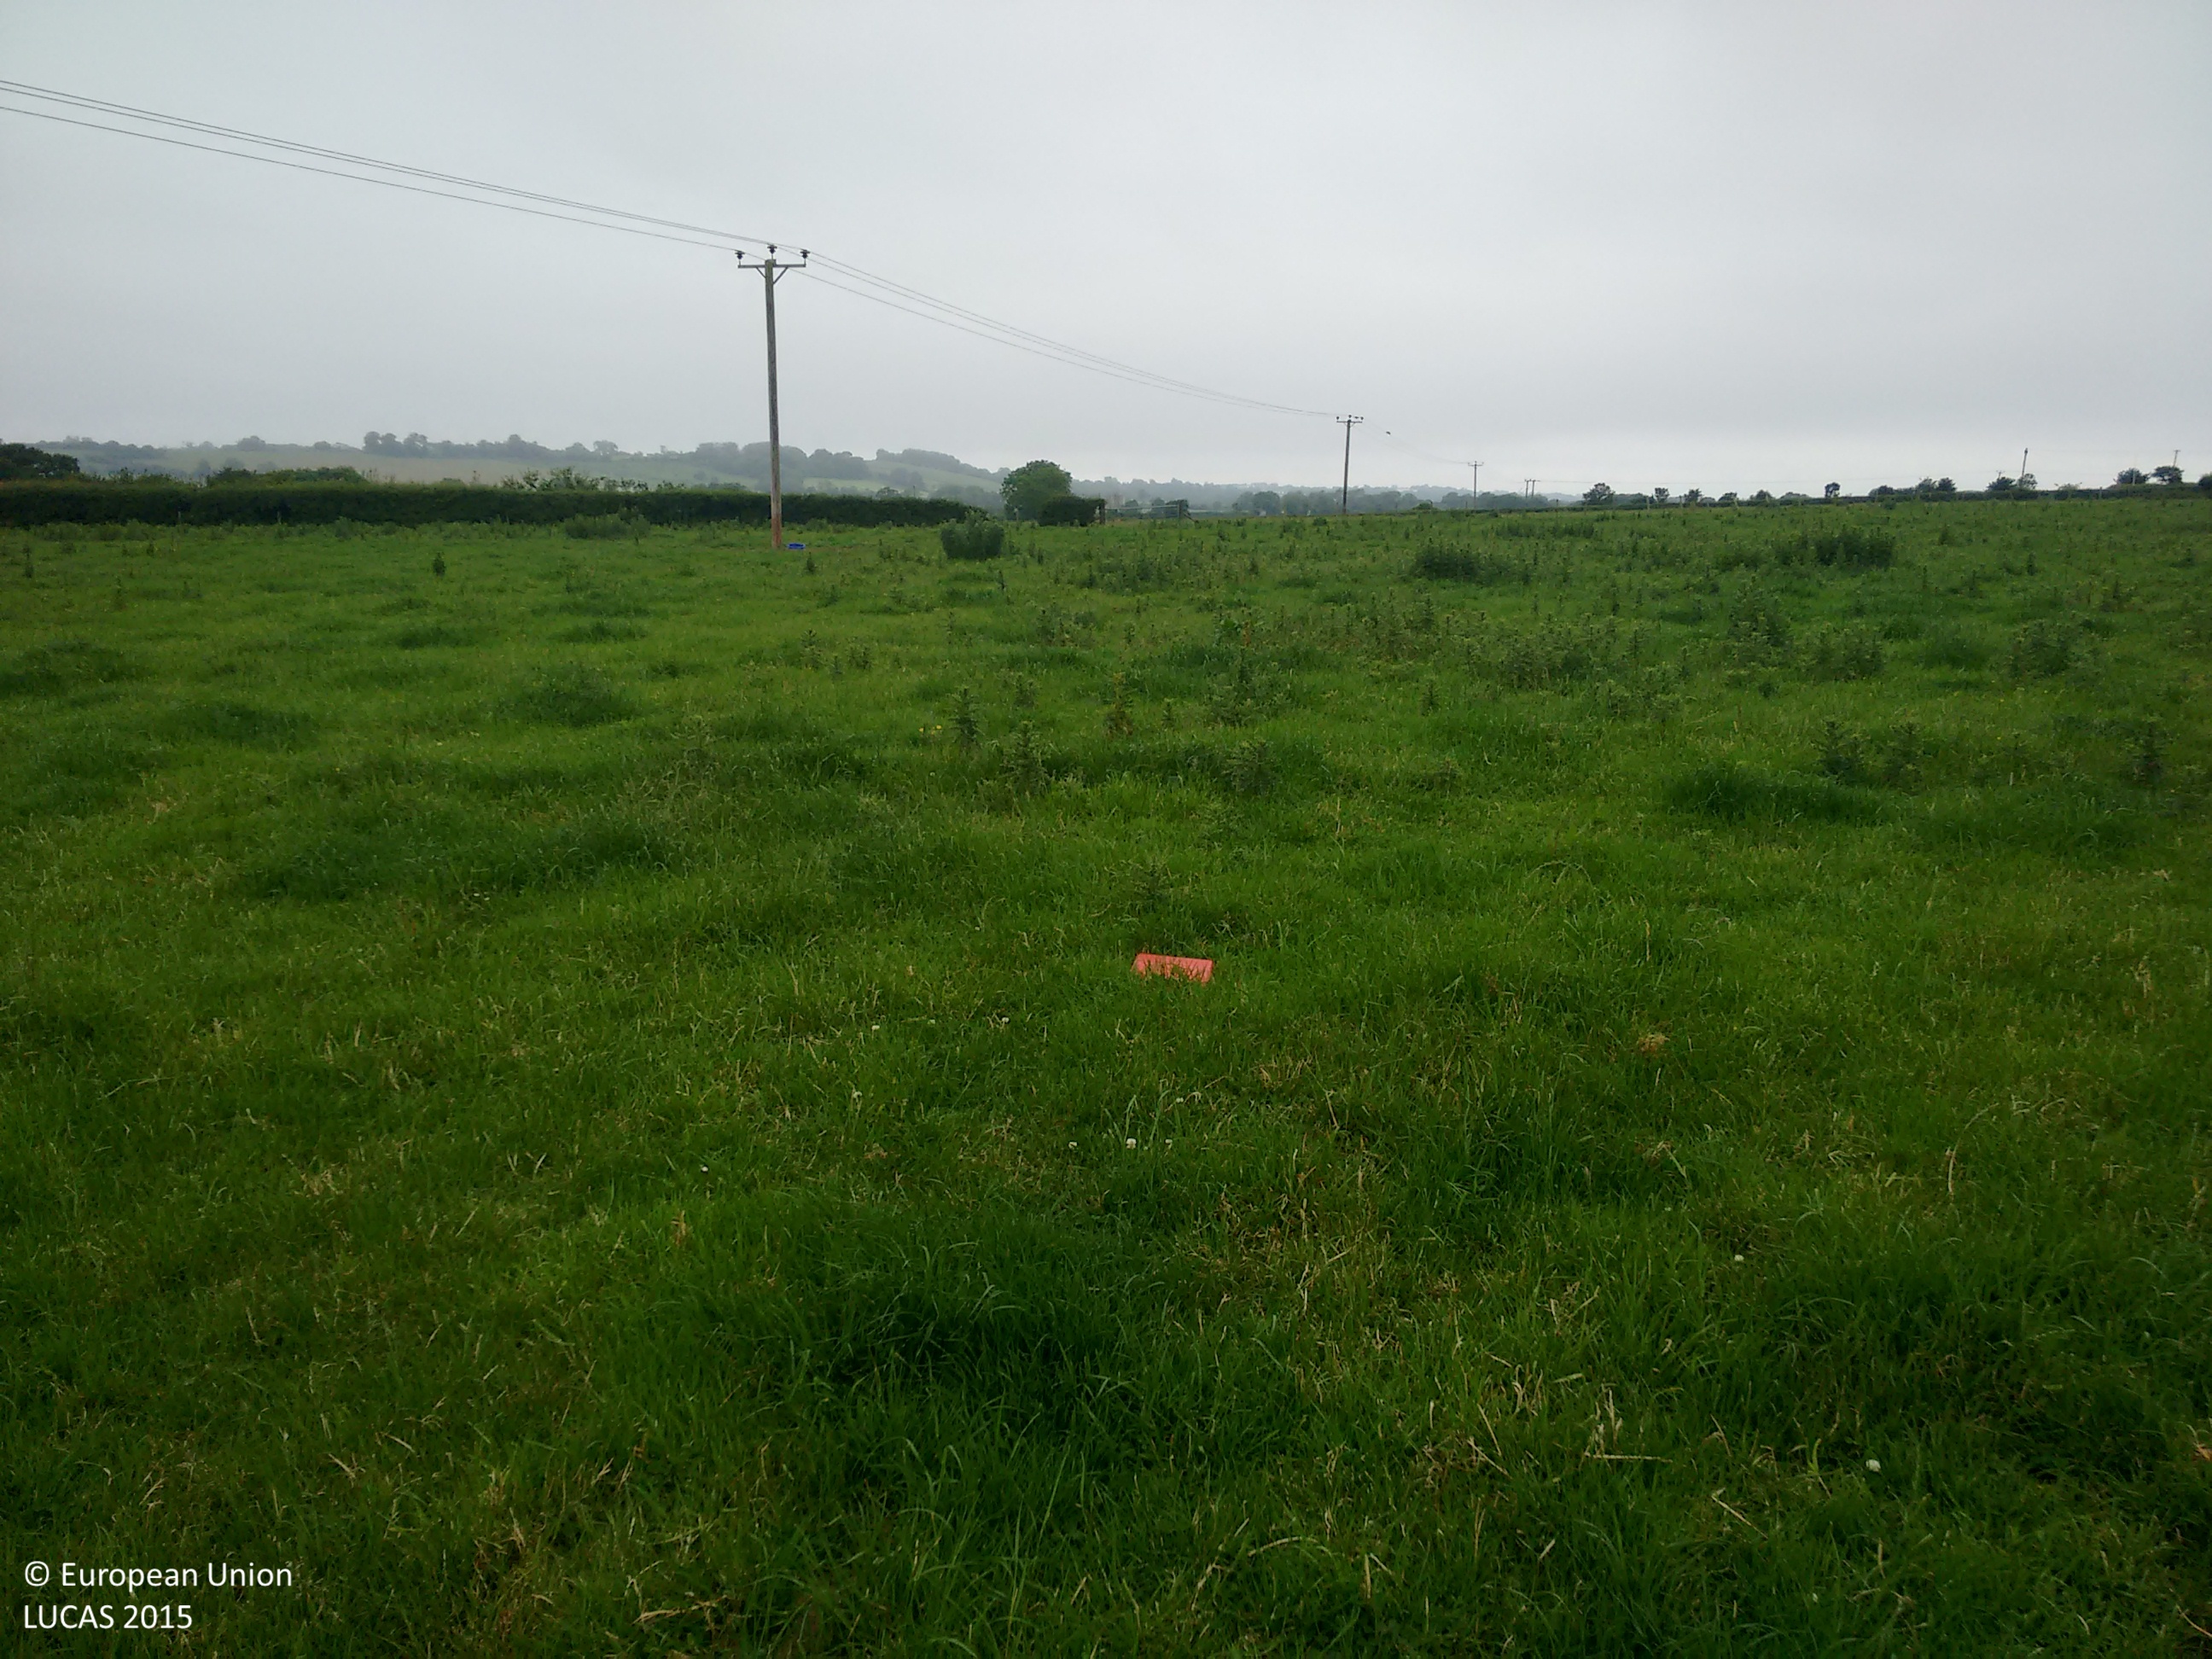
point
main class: Grassland
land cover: Grassland without tree/shrub cover
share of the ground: > 75 %
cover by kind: herbaceous plants 100 %
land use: Agriculture (excluding fallow land and kitchen gardens)
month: June
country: GB
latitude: 51.1474
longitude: -2.5177
